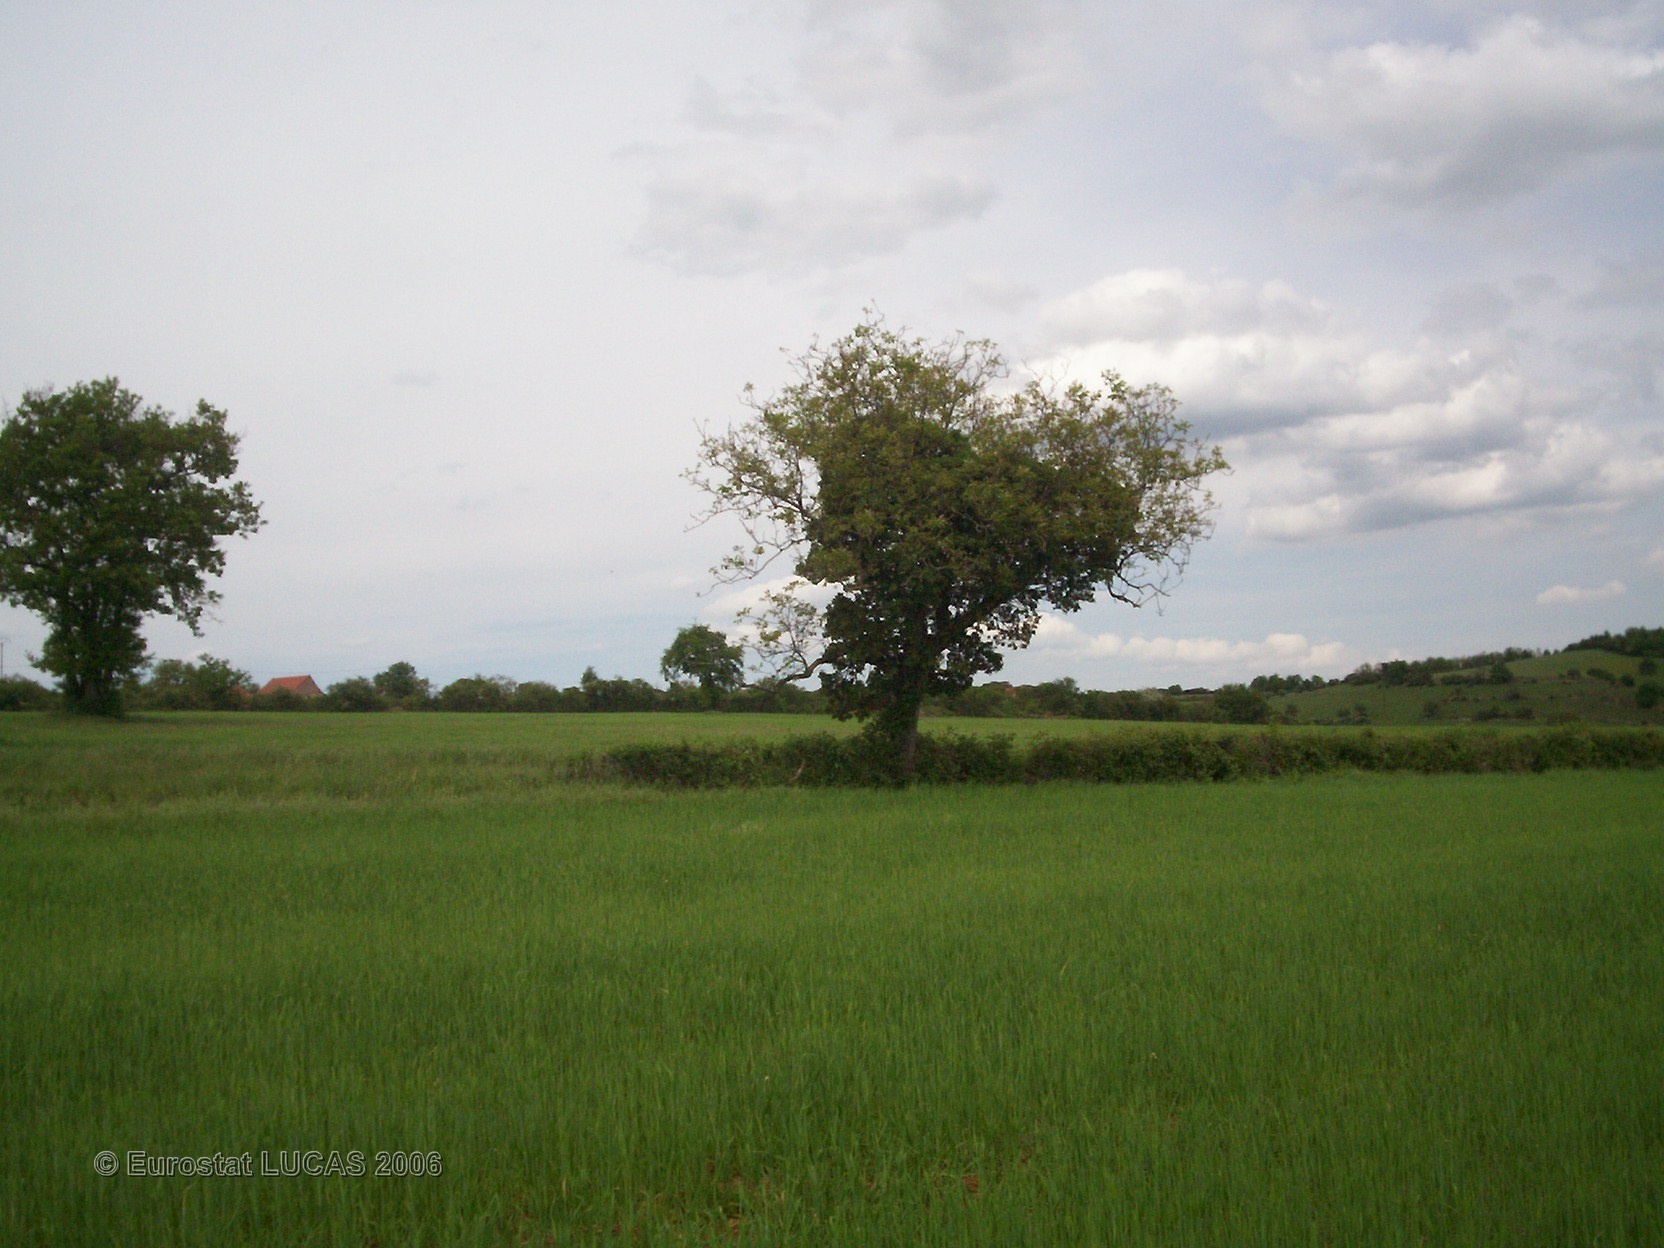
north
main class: Cropland
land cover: Barley
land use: Agriculture (excluding fallow land and kitchen gardens)
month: May
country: FR
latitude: 46.5598
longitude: 4.6401
